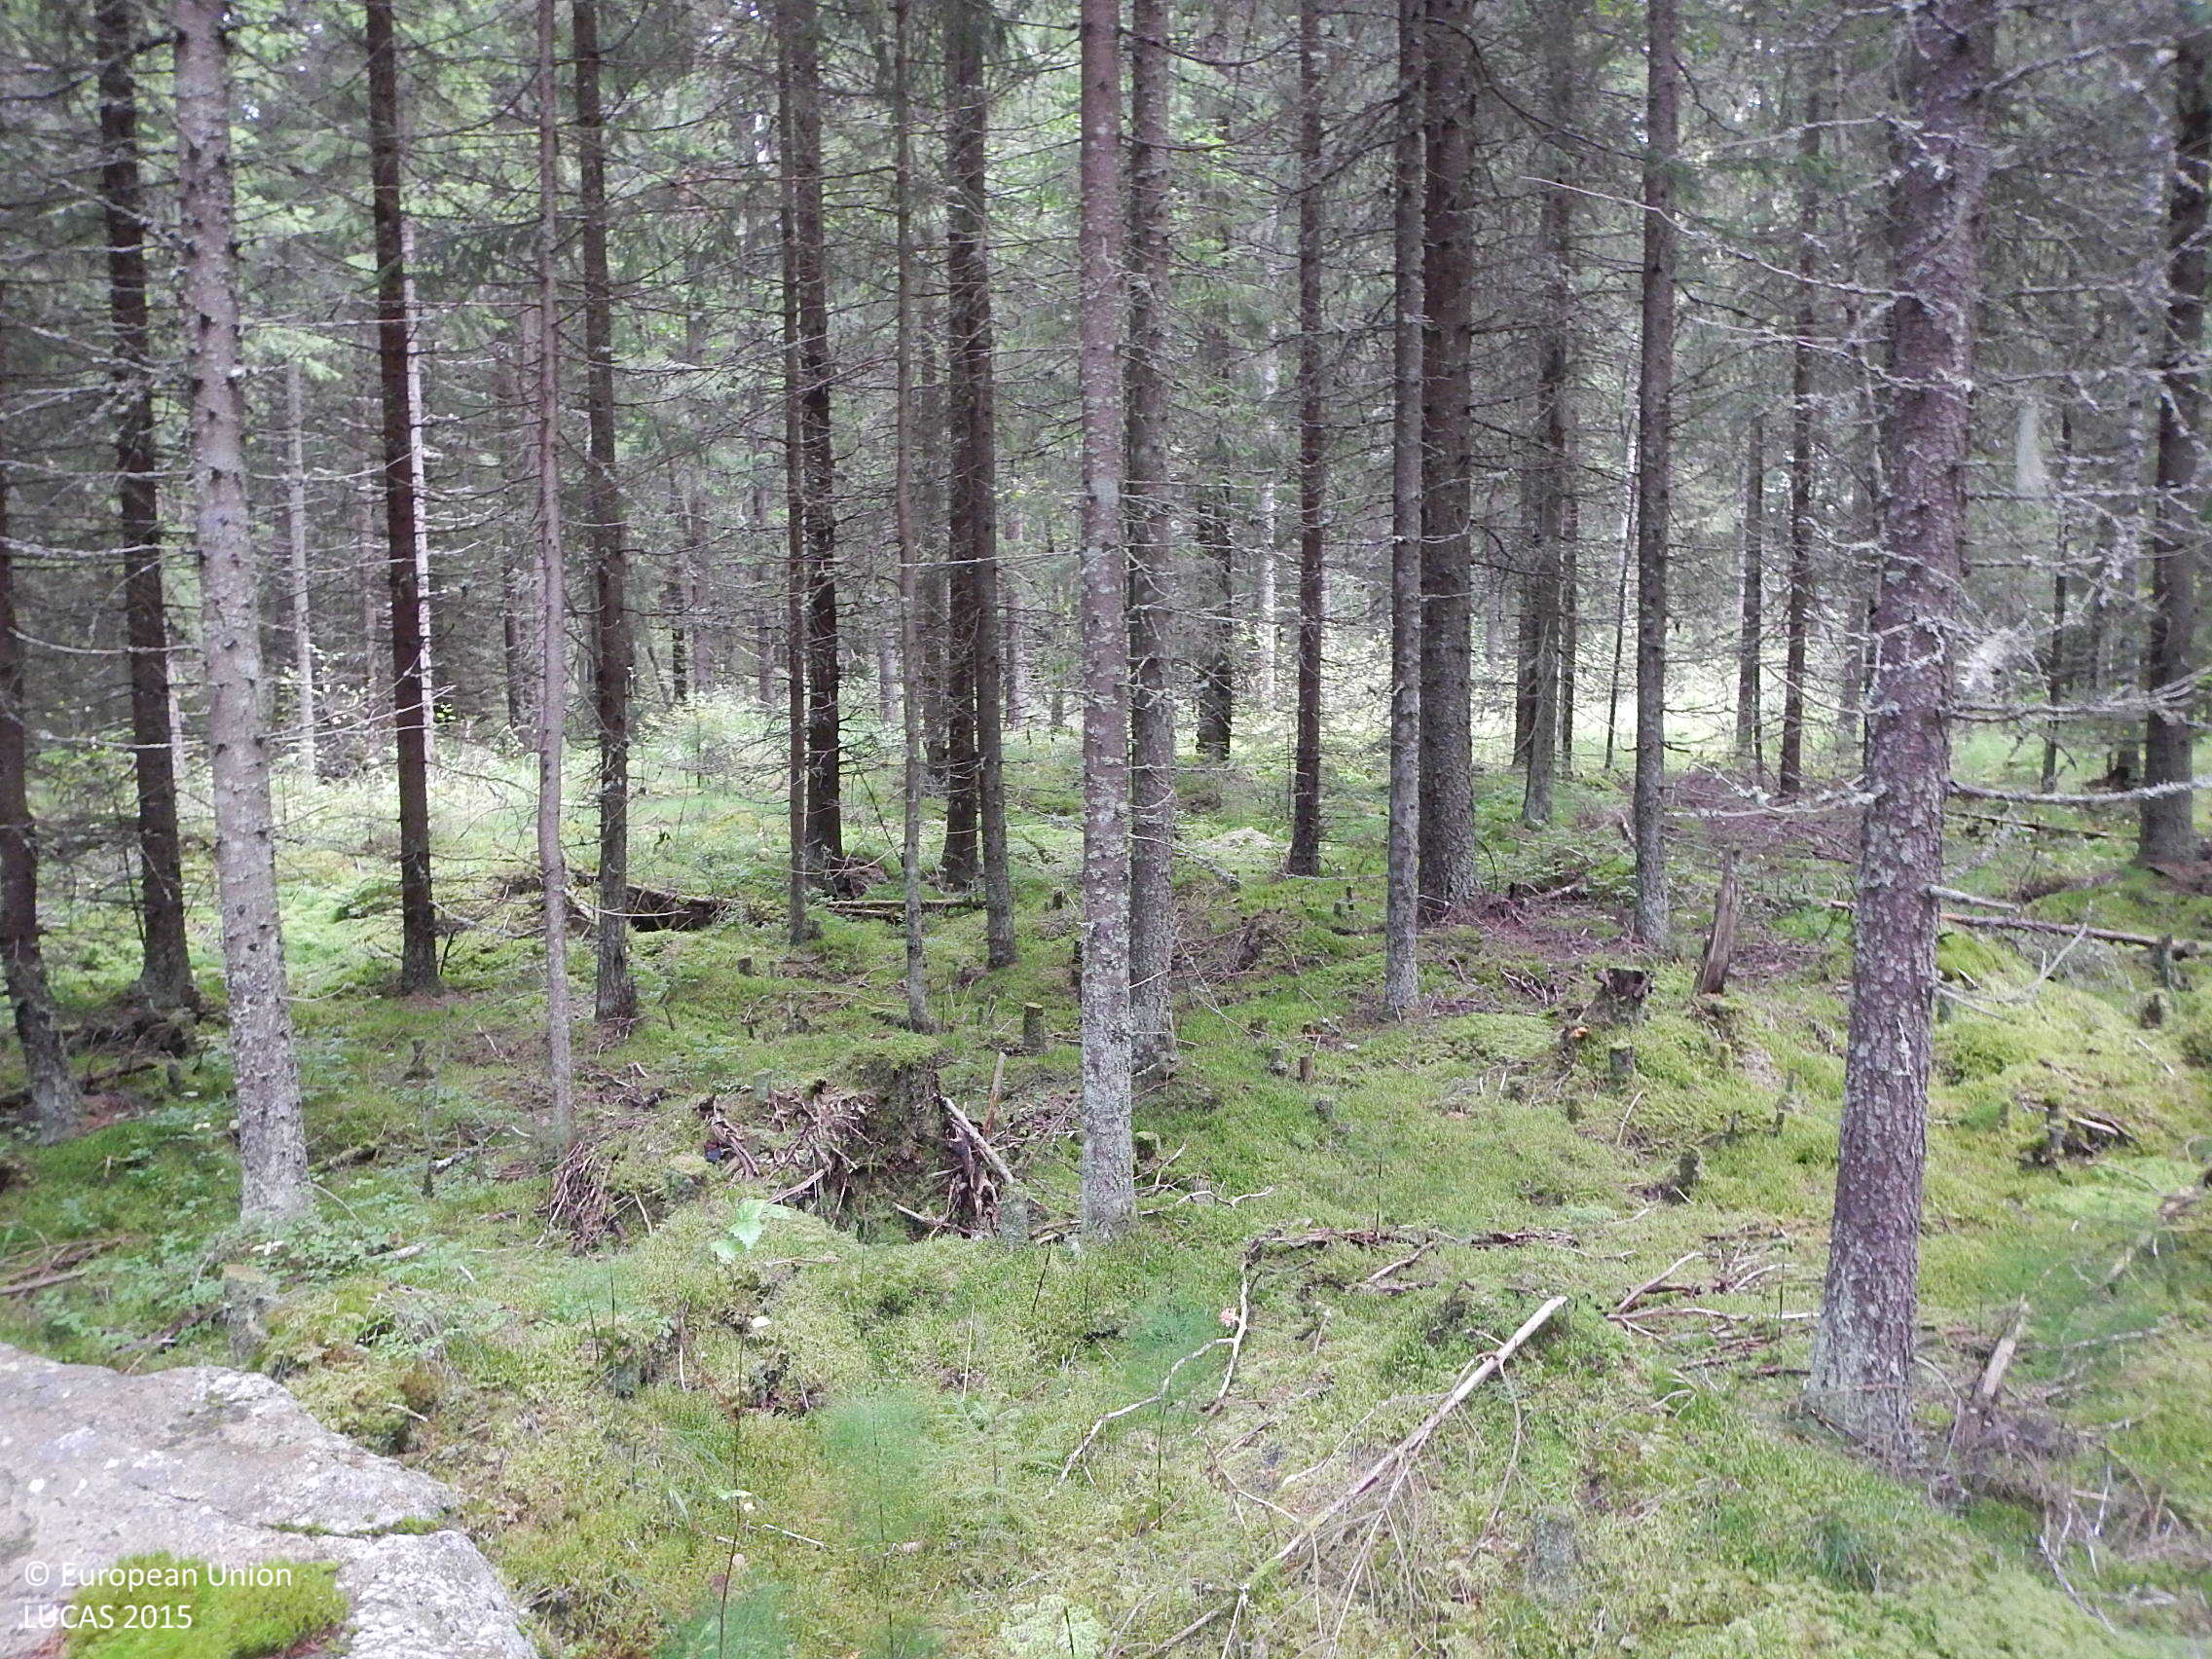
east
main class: Woodland
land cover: Spruce dominated coniferous woodland
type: boreal forest
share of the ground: > 75 %
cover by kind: coniferous forest trees 75 %, lichens and mosses 20 %, herbaceous plants 5 %
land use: Forestry
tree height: > 5 m
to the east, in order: Spruce dominated coniferous woodland; Ditches and canals; Spruce dominated coniferous woodland; Ditches and canals; Spruce dominated coniferous woodland; Spruce dominated mixed woodland; Ditches and canals; Spruce dominated mixed woodland; Other mixed woodland
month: September
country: FI
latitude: 61.3918
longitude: 22.0967
